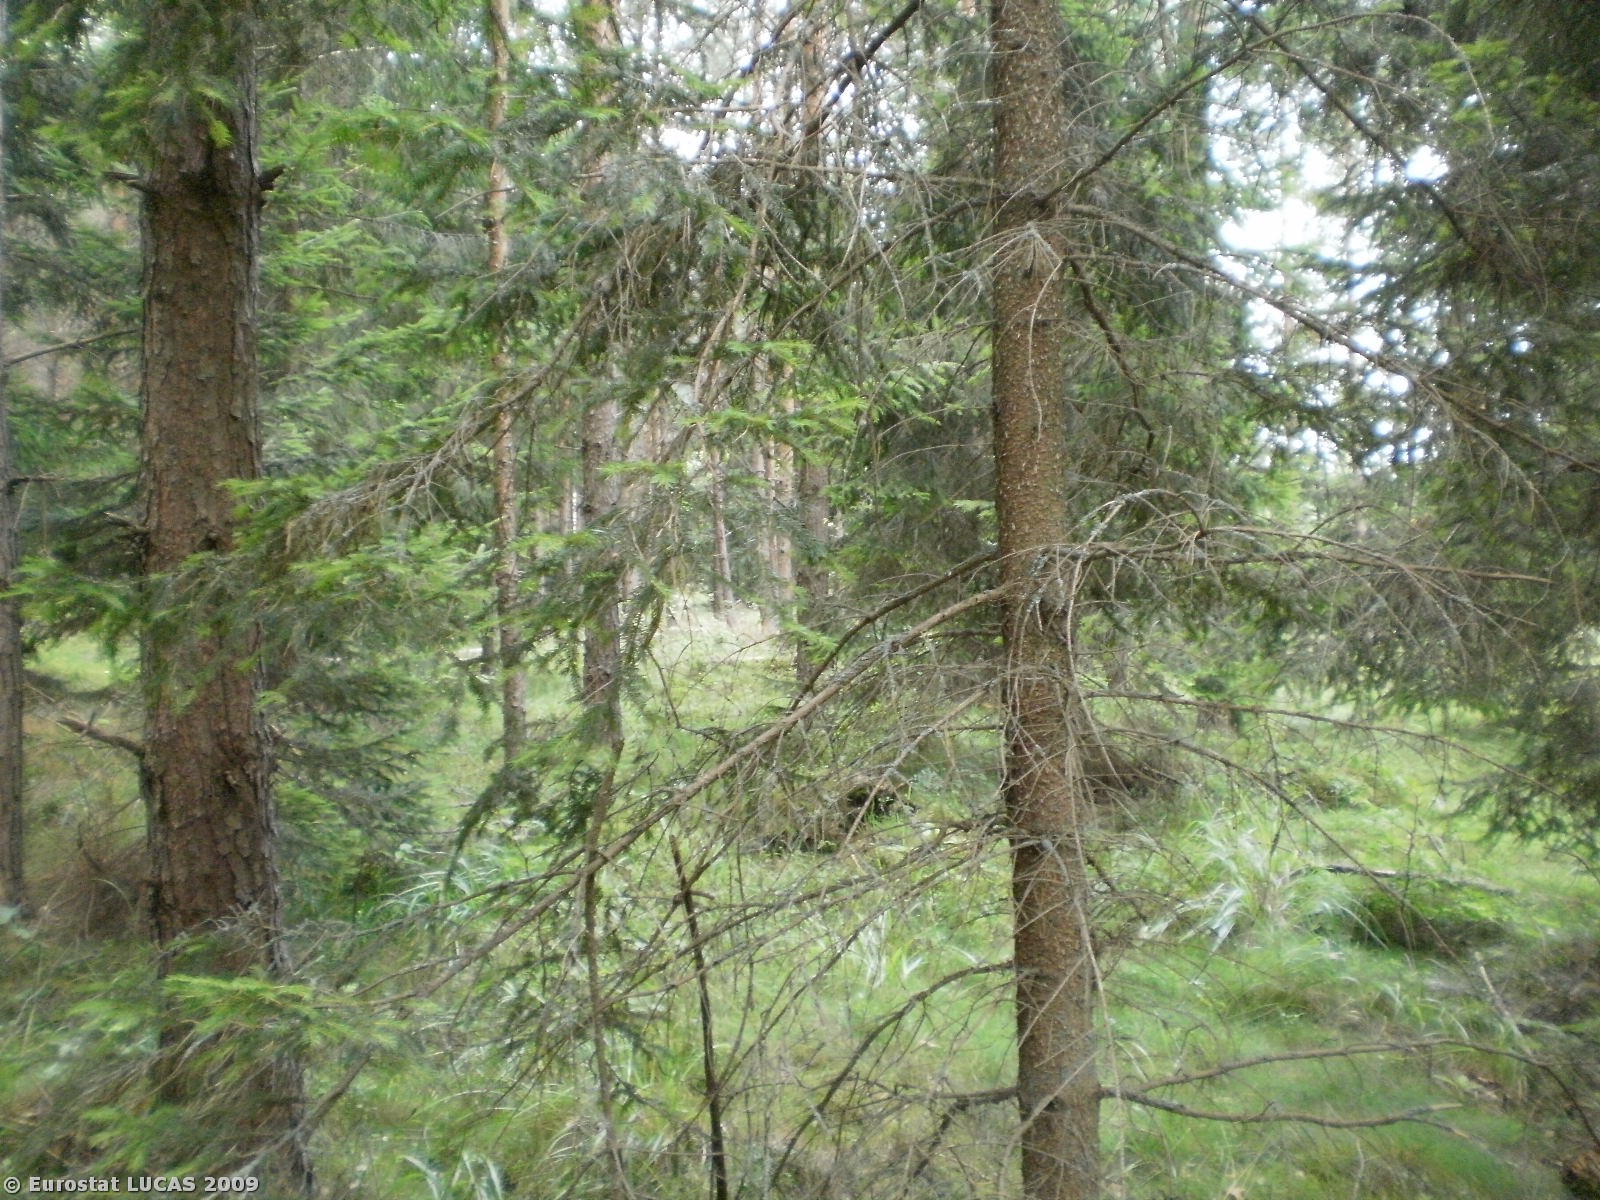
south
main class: Woodland
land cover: Coniferous woodland
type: hemiboreal forest and nemoral coniferous forest and mixed broadleaved-coniferous forest
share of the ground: > 75 %
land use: Forestry
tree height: > 5 m
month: July
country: PL
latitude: 53.5661
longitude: 21.0511
